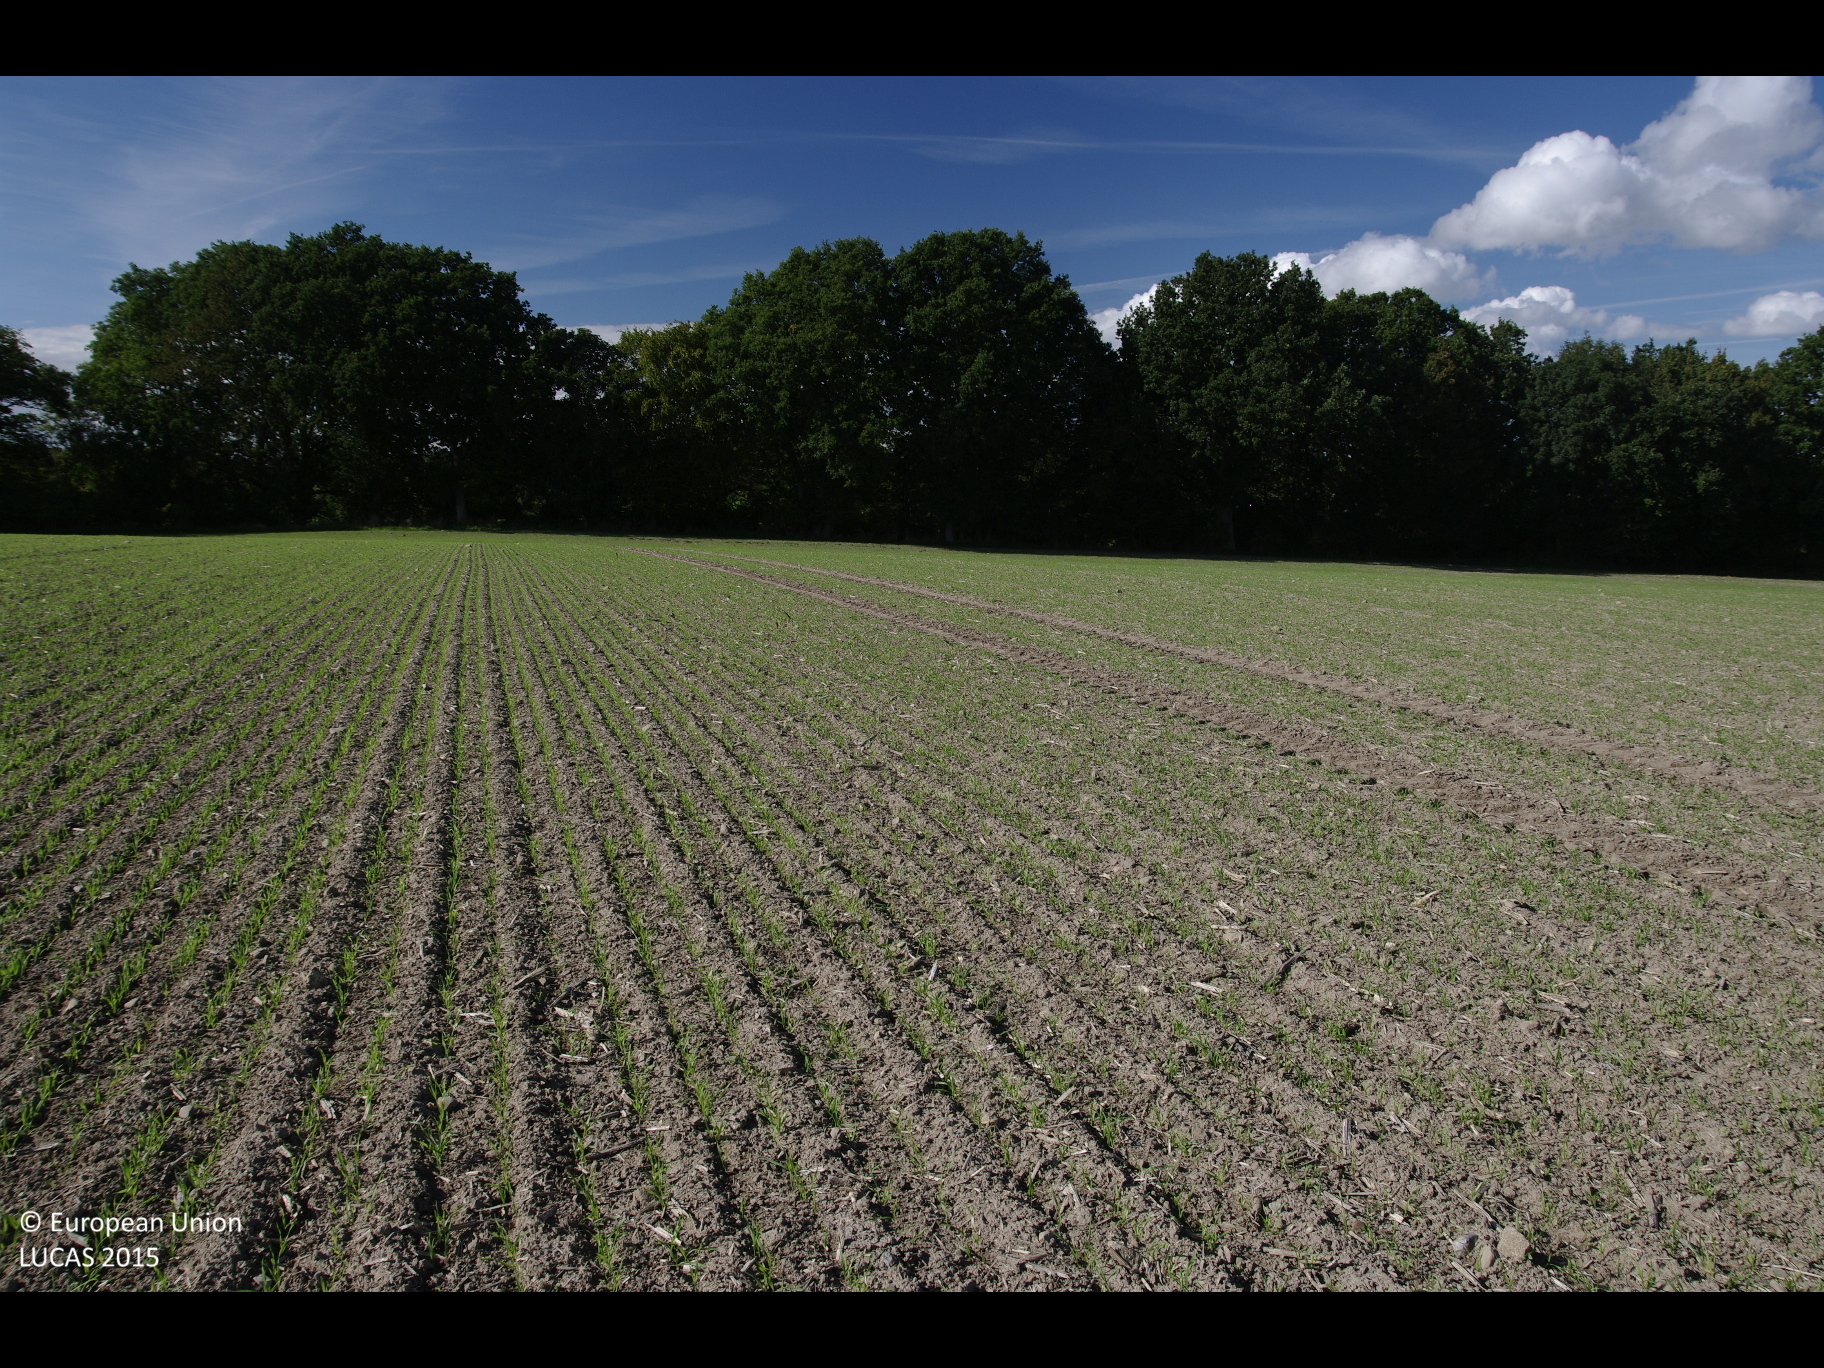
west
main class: Cropland
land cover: Rape and turnip rape
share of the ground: < 10 %
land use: Agriculture (excluding fallow land and kitchen gardens)
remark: Harvested field
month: September
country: DE
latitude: 53.9178
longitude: 11.1413
